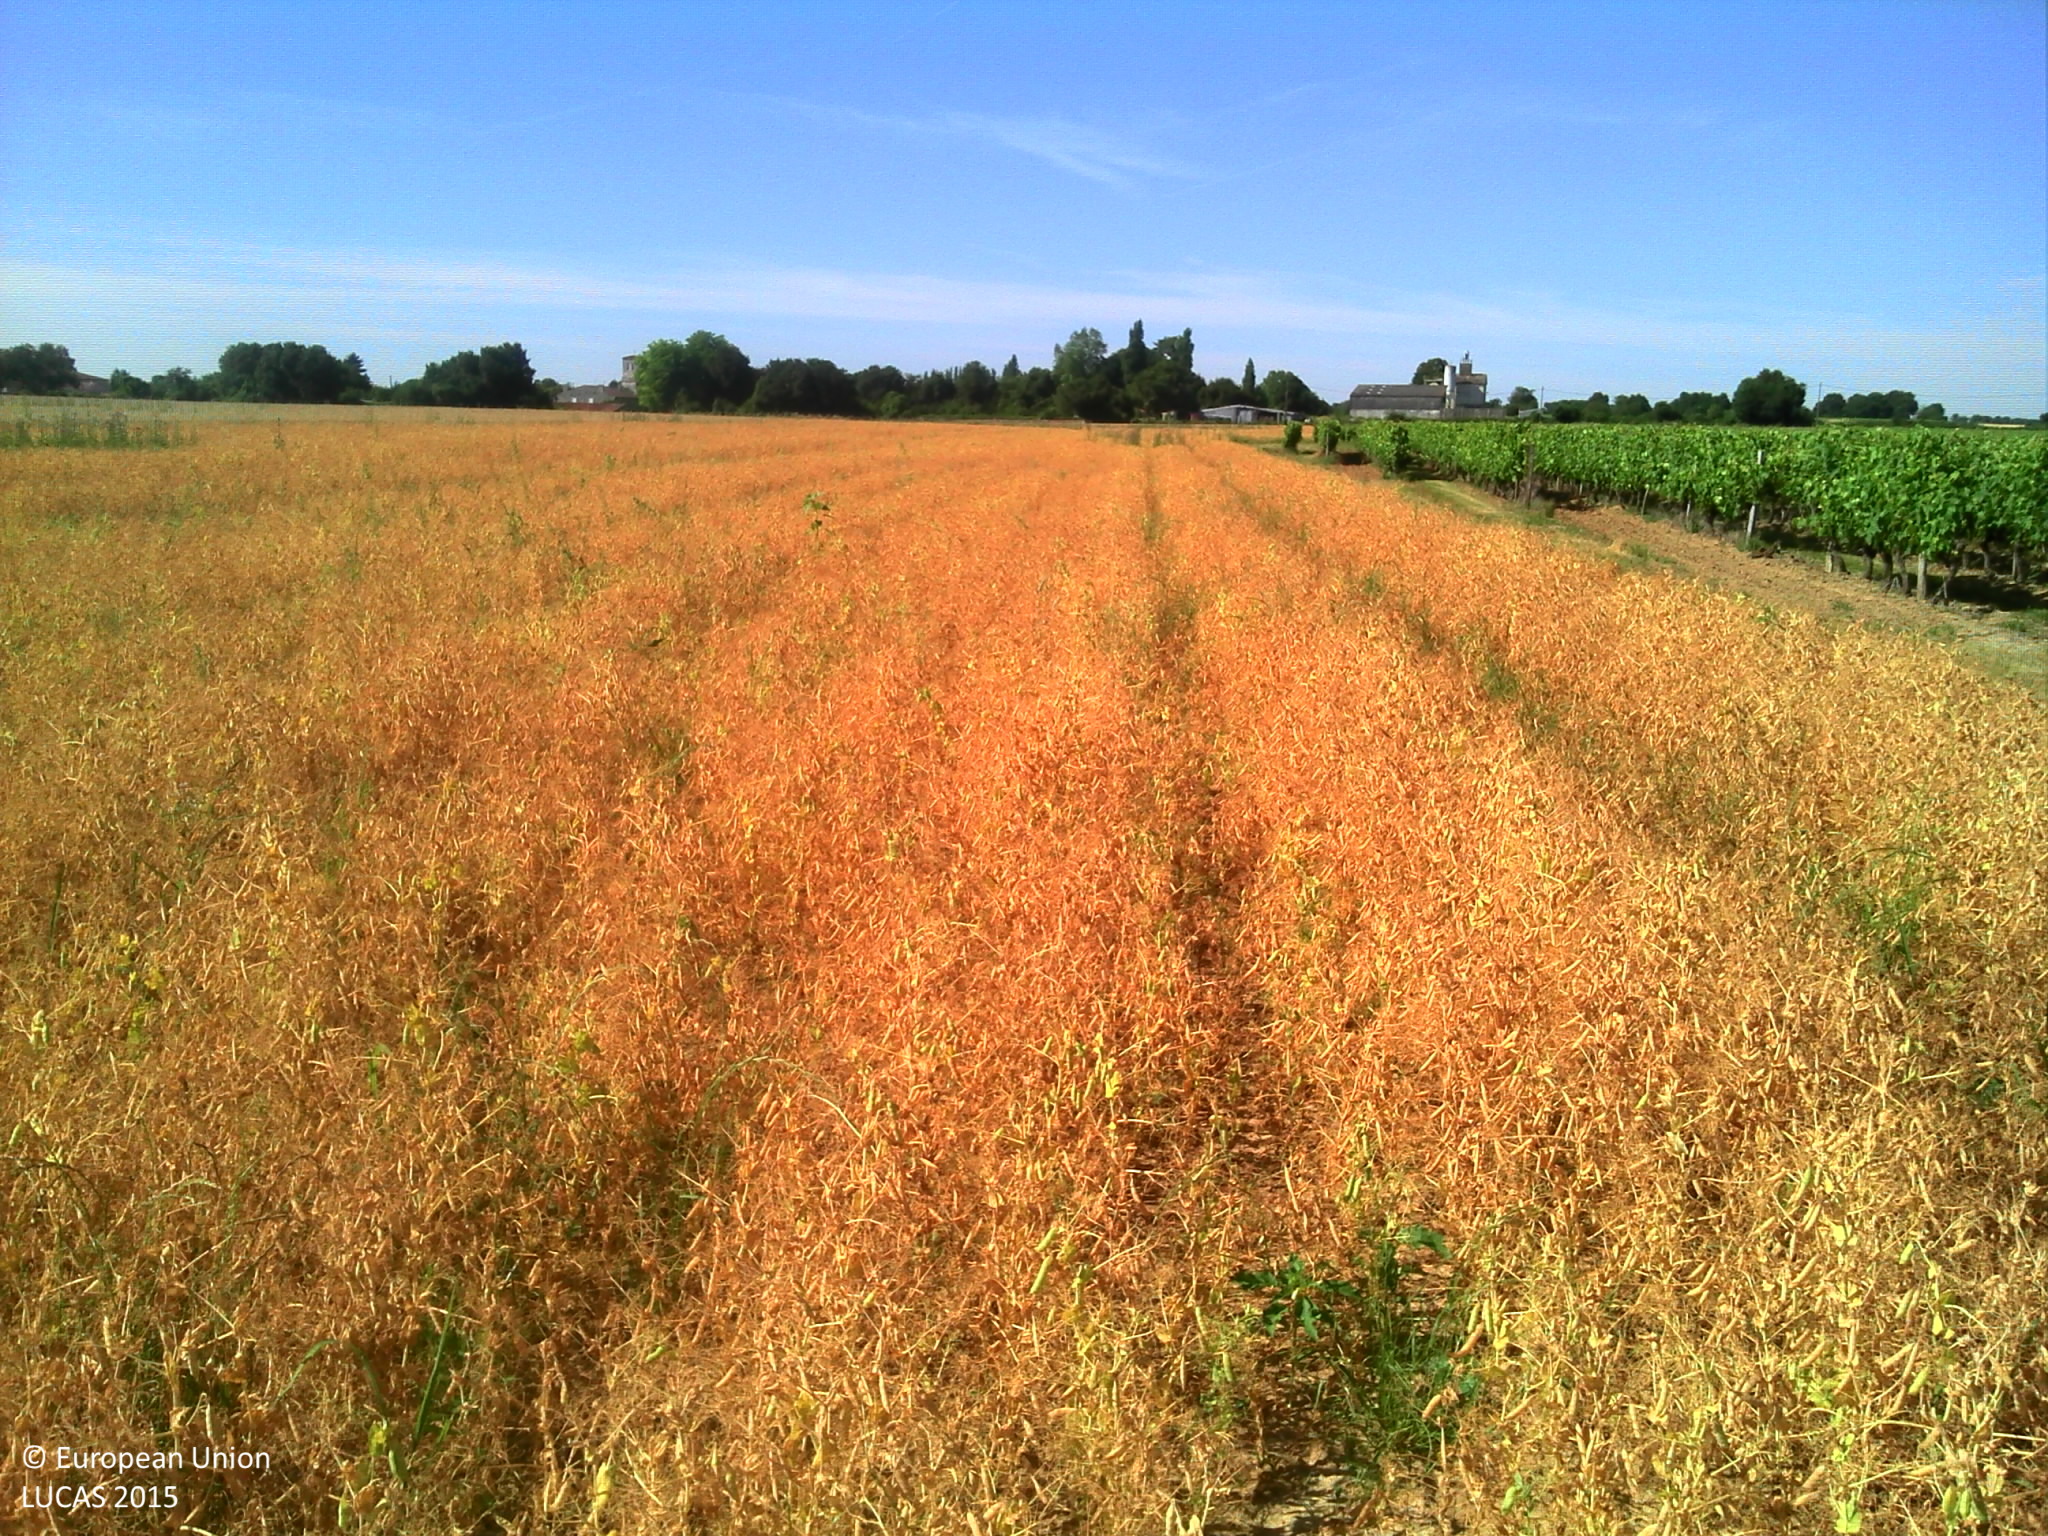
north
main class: Cropland
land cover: Dry pulses
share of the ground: > 75 %
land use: Agriculture (excluding fallow land and kitchen gardens)
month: June
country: FR
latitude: 45.6303
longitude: -0.7094
